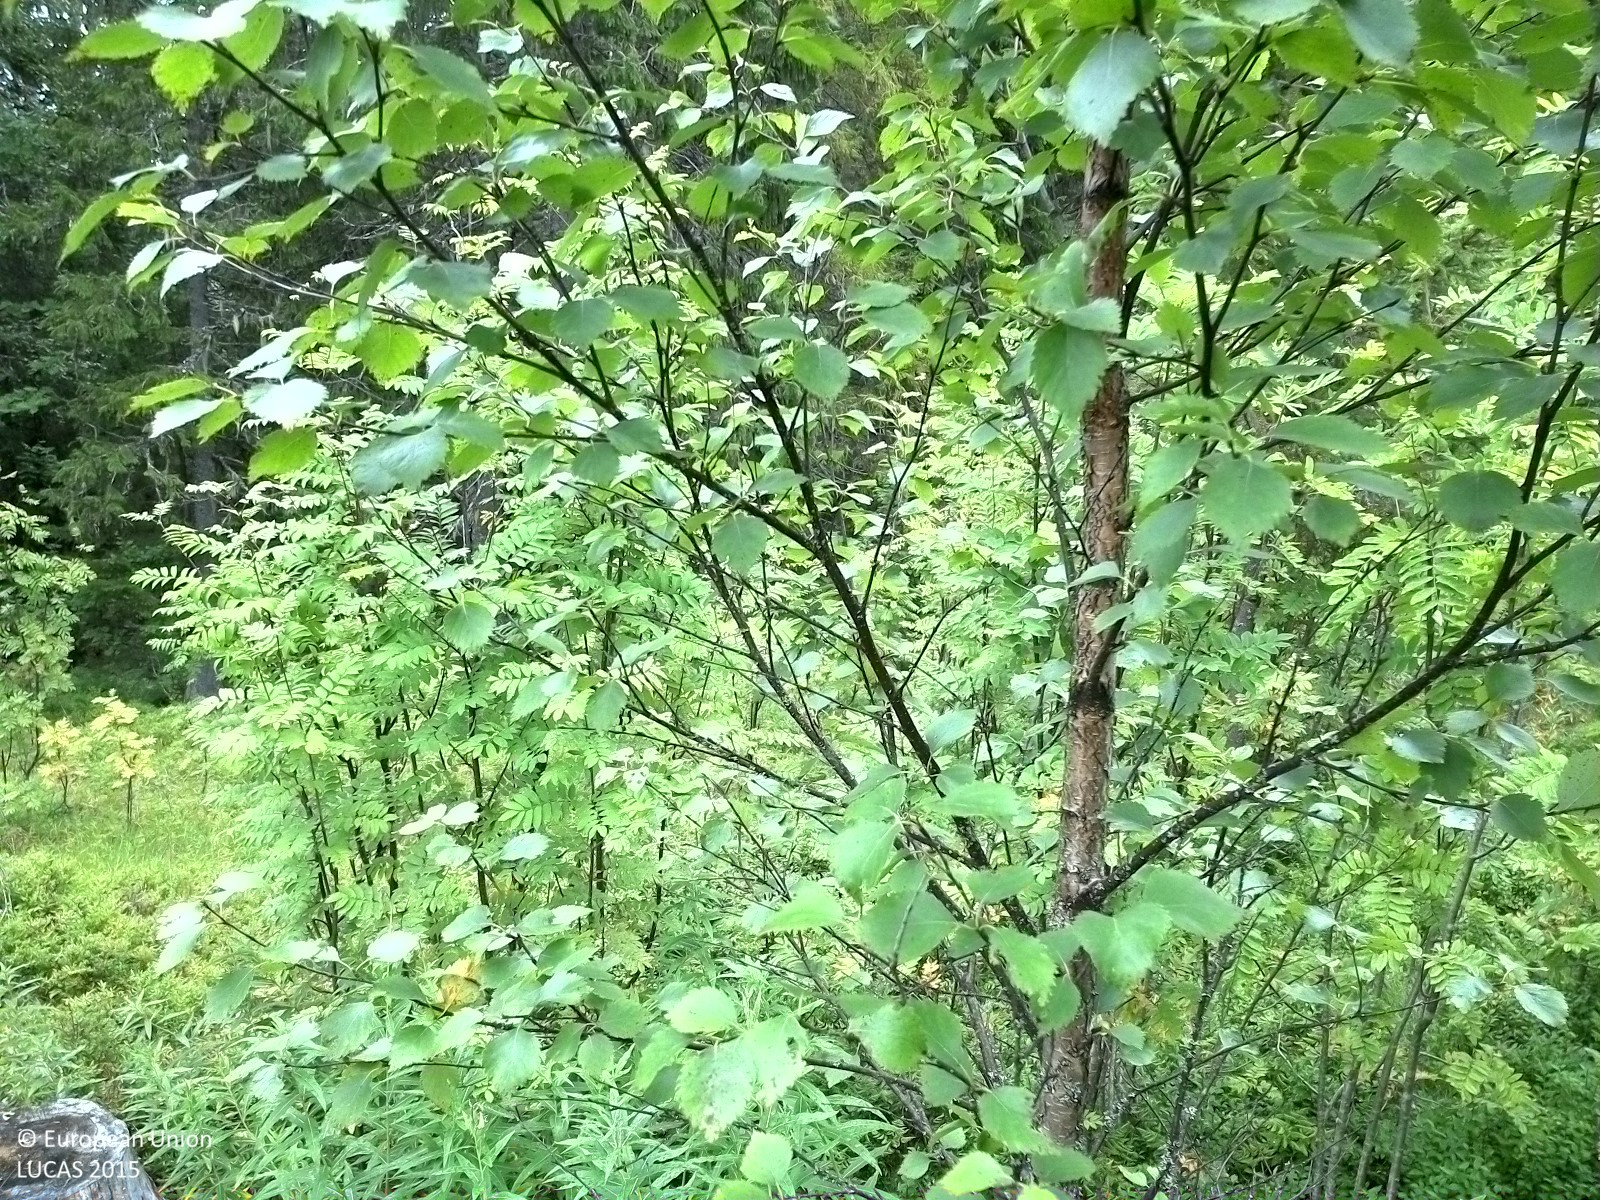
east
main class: Woodland
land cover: Spruce dominated mixed woodland
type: boreal forest
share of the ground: 25 - 50 %
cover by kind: herbaceous plants 30 %, coniferous forest trees 25 %, broadleaved forest trees 25 %, shrubs 20 %
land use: Forestry
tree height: > 5 m
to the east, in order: Spruce dominated mixed woodland; Spruce dominated coniferous woodland; Ditches and canals; Spruce dominated coniferous woodland
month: August
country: SE
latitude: 62.2839
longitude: 16.2441
